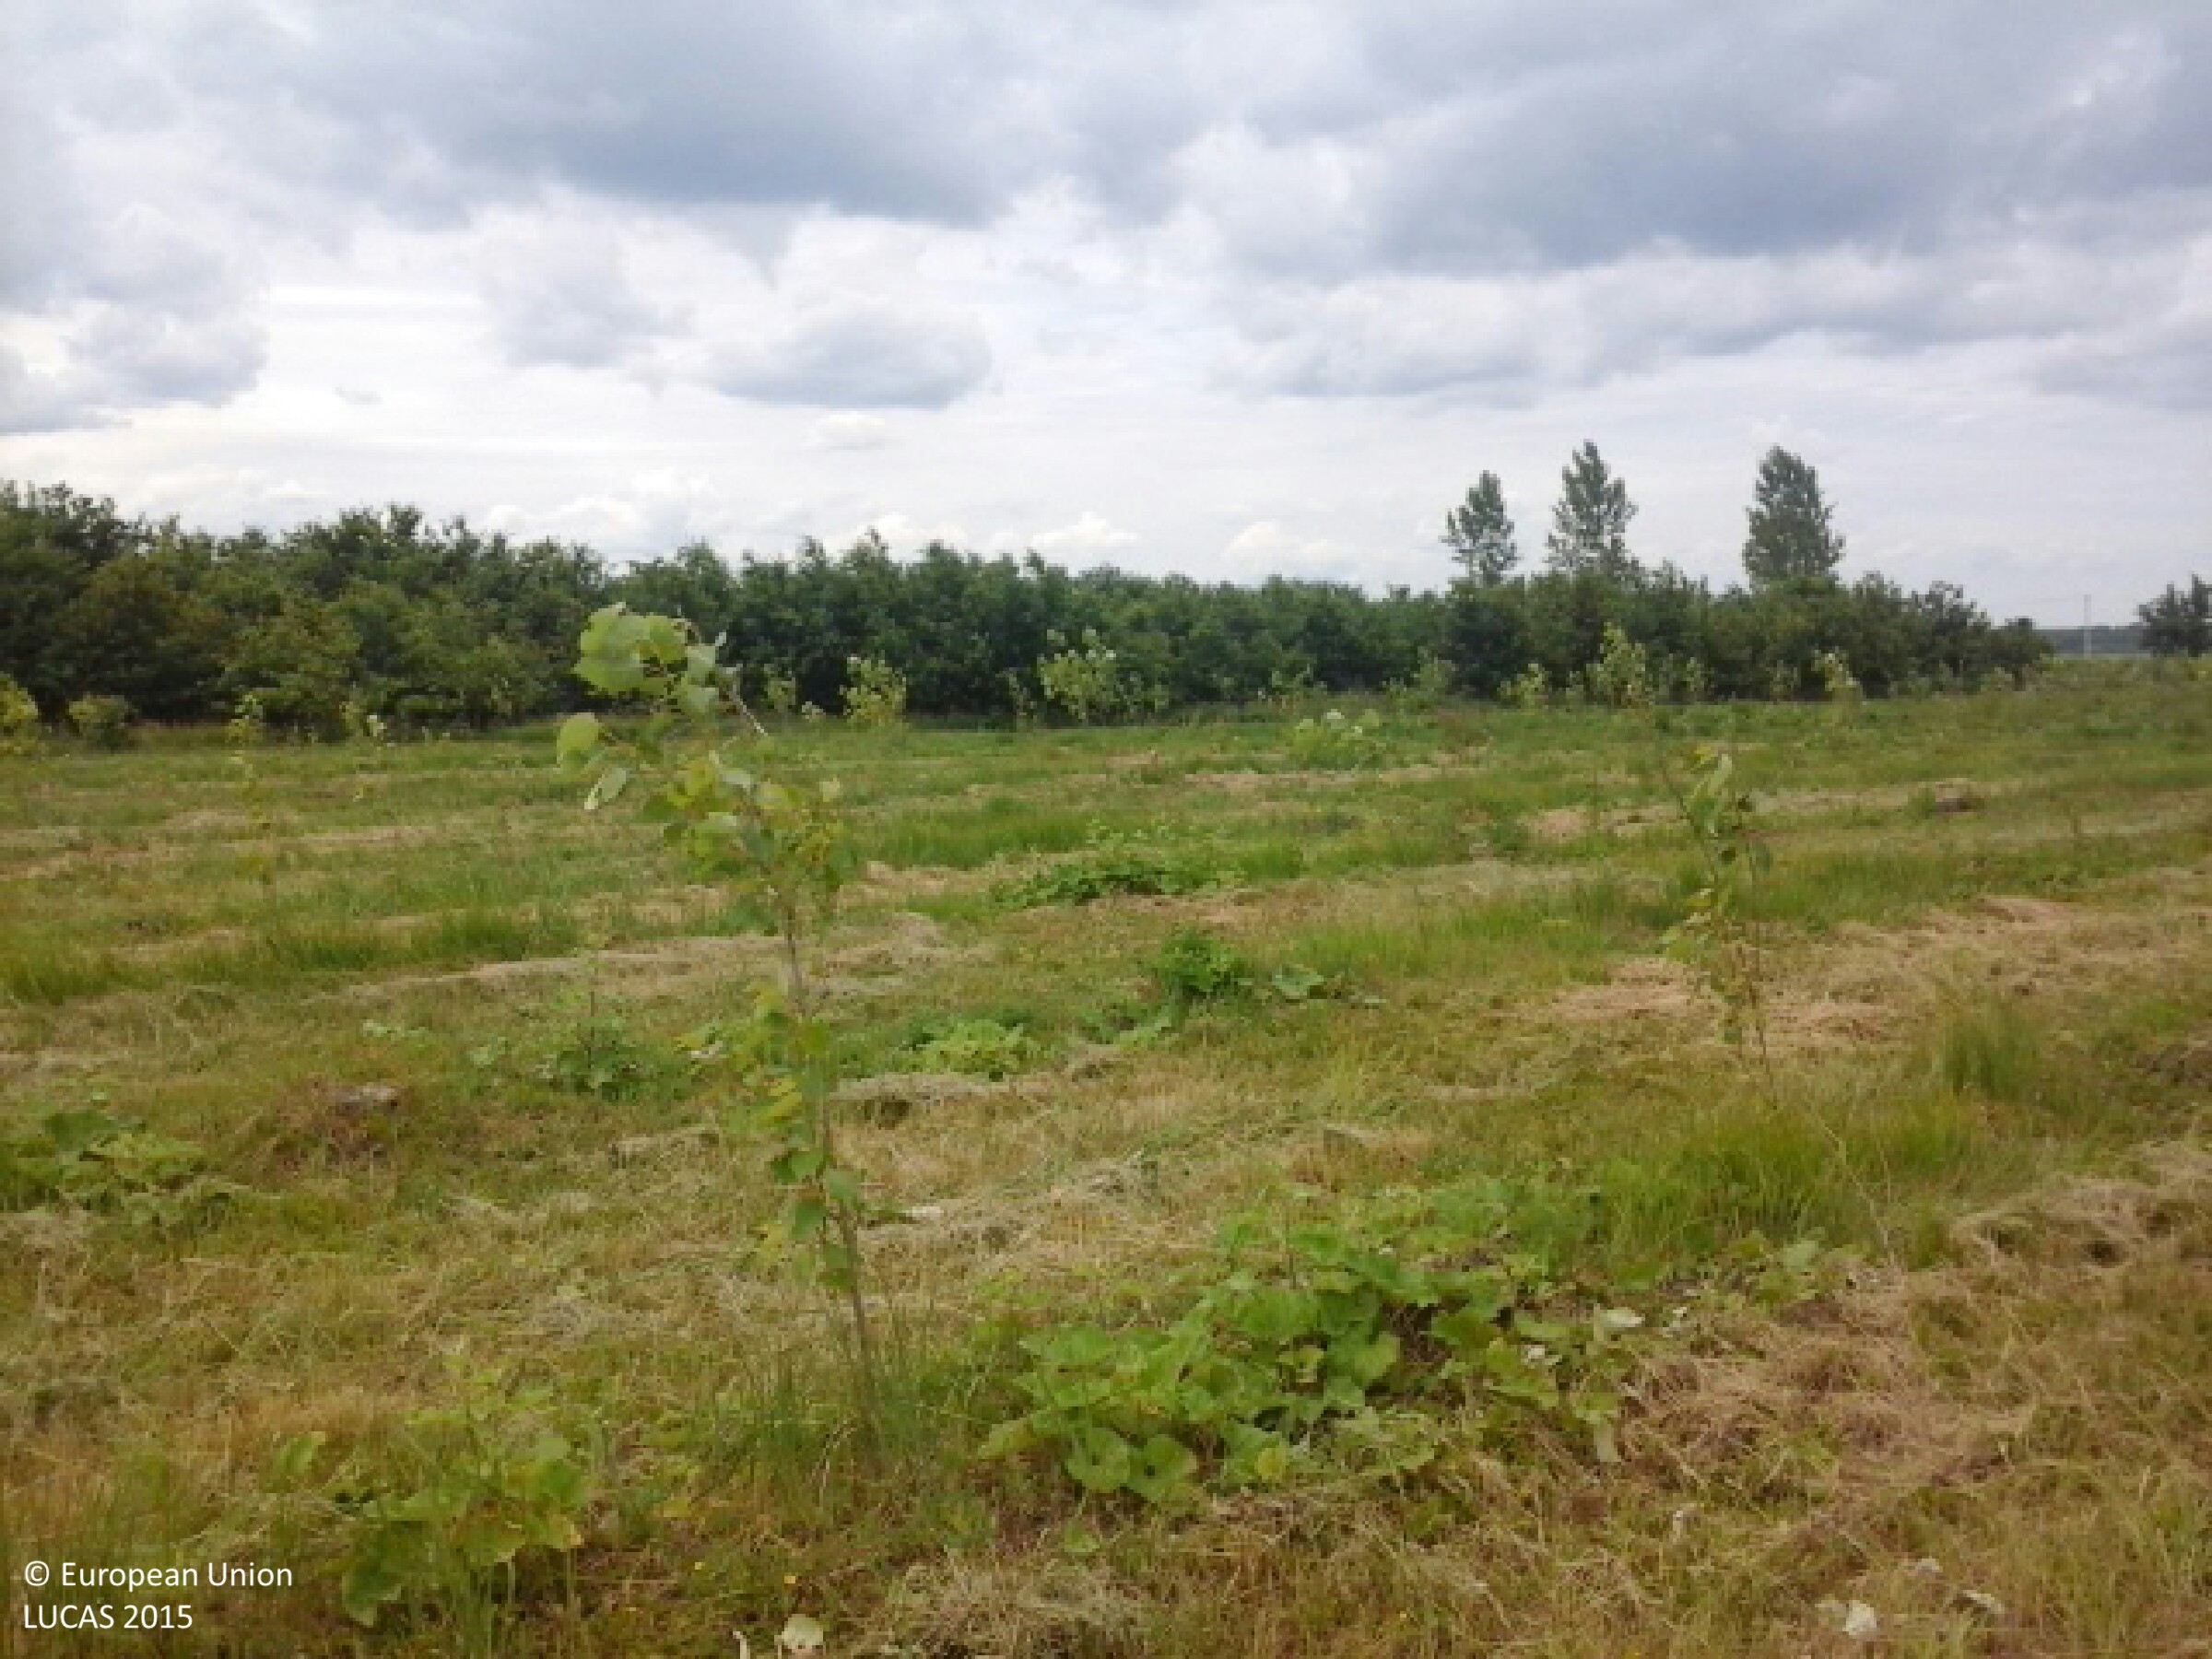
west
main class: Grassland
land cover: Grassland with sparse tree/shrub cover
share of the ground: > 75 %
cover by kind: herbaceous plants 95 %, broadleaved forest trees 5 %
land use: Agriculture (excluding fallow land and kitchen gardens)
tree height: < 5 m
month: June
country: HU
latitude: 48.1732
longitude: 21.7622
